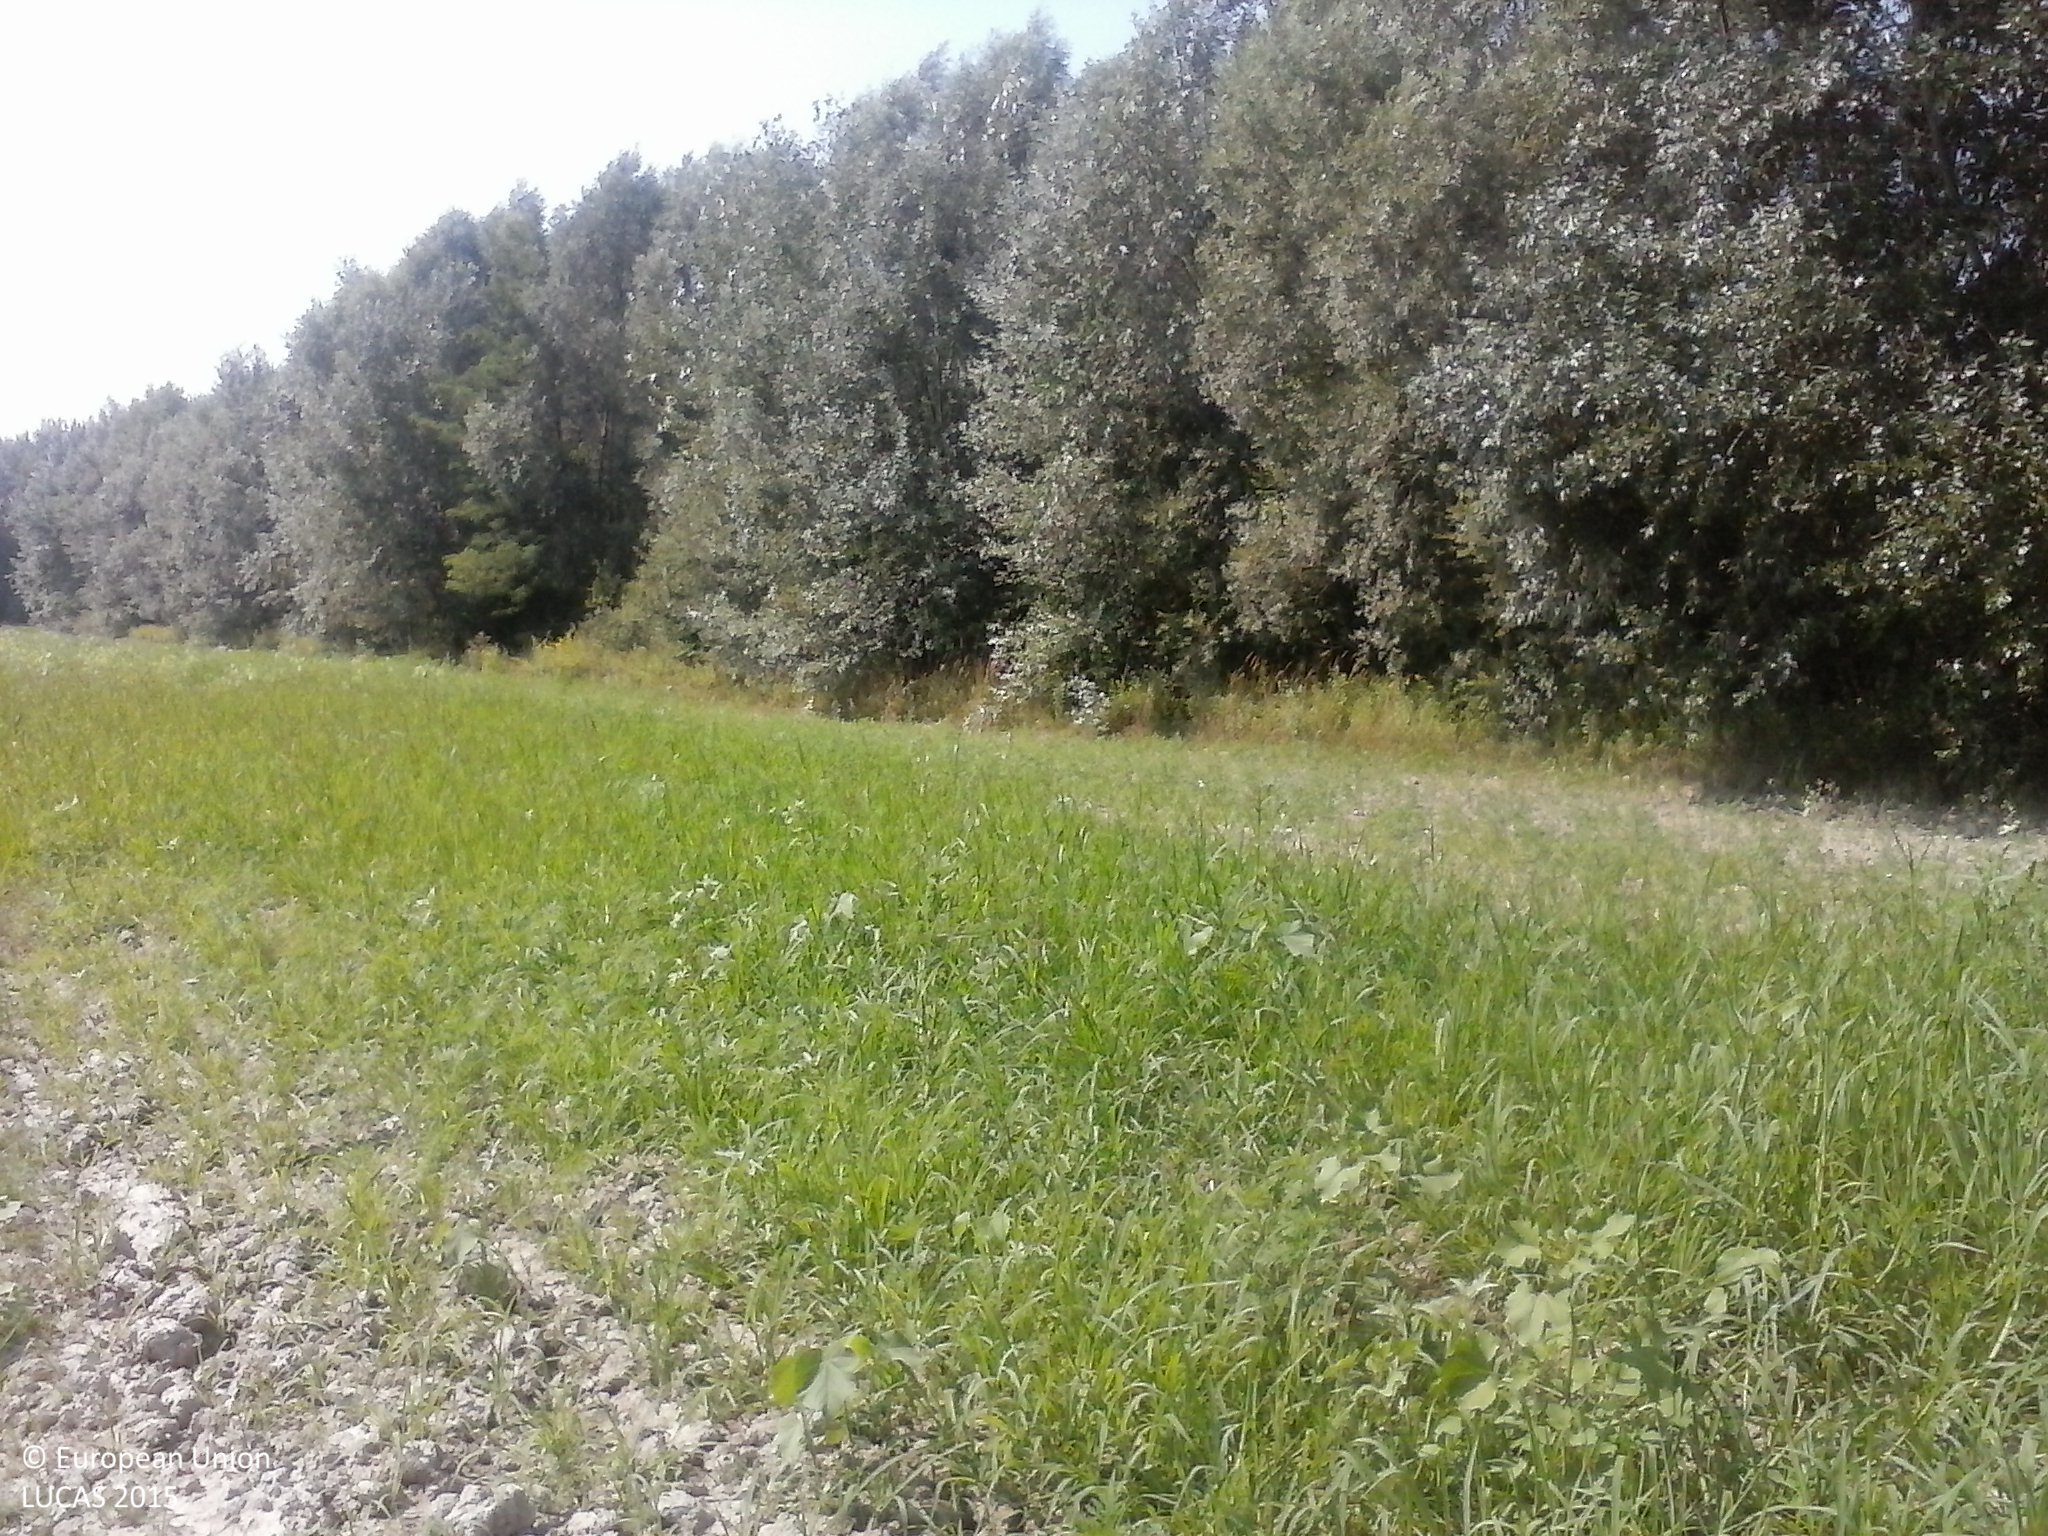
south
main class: Grassland
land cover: Spontaneously vegetated surfaces
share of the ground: > 75 %
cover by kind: herbaceous plants 80 %, unconsolidated bare surface 20 %
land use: Fallow land
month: August
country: HU
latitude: 45.8673
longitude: 17.7976
